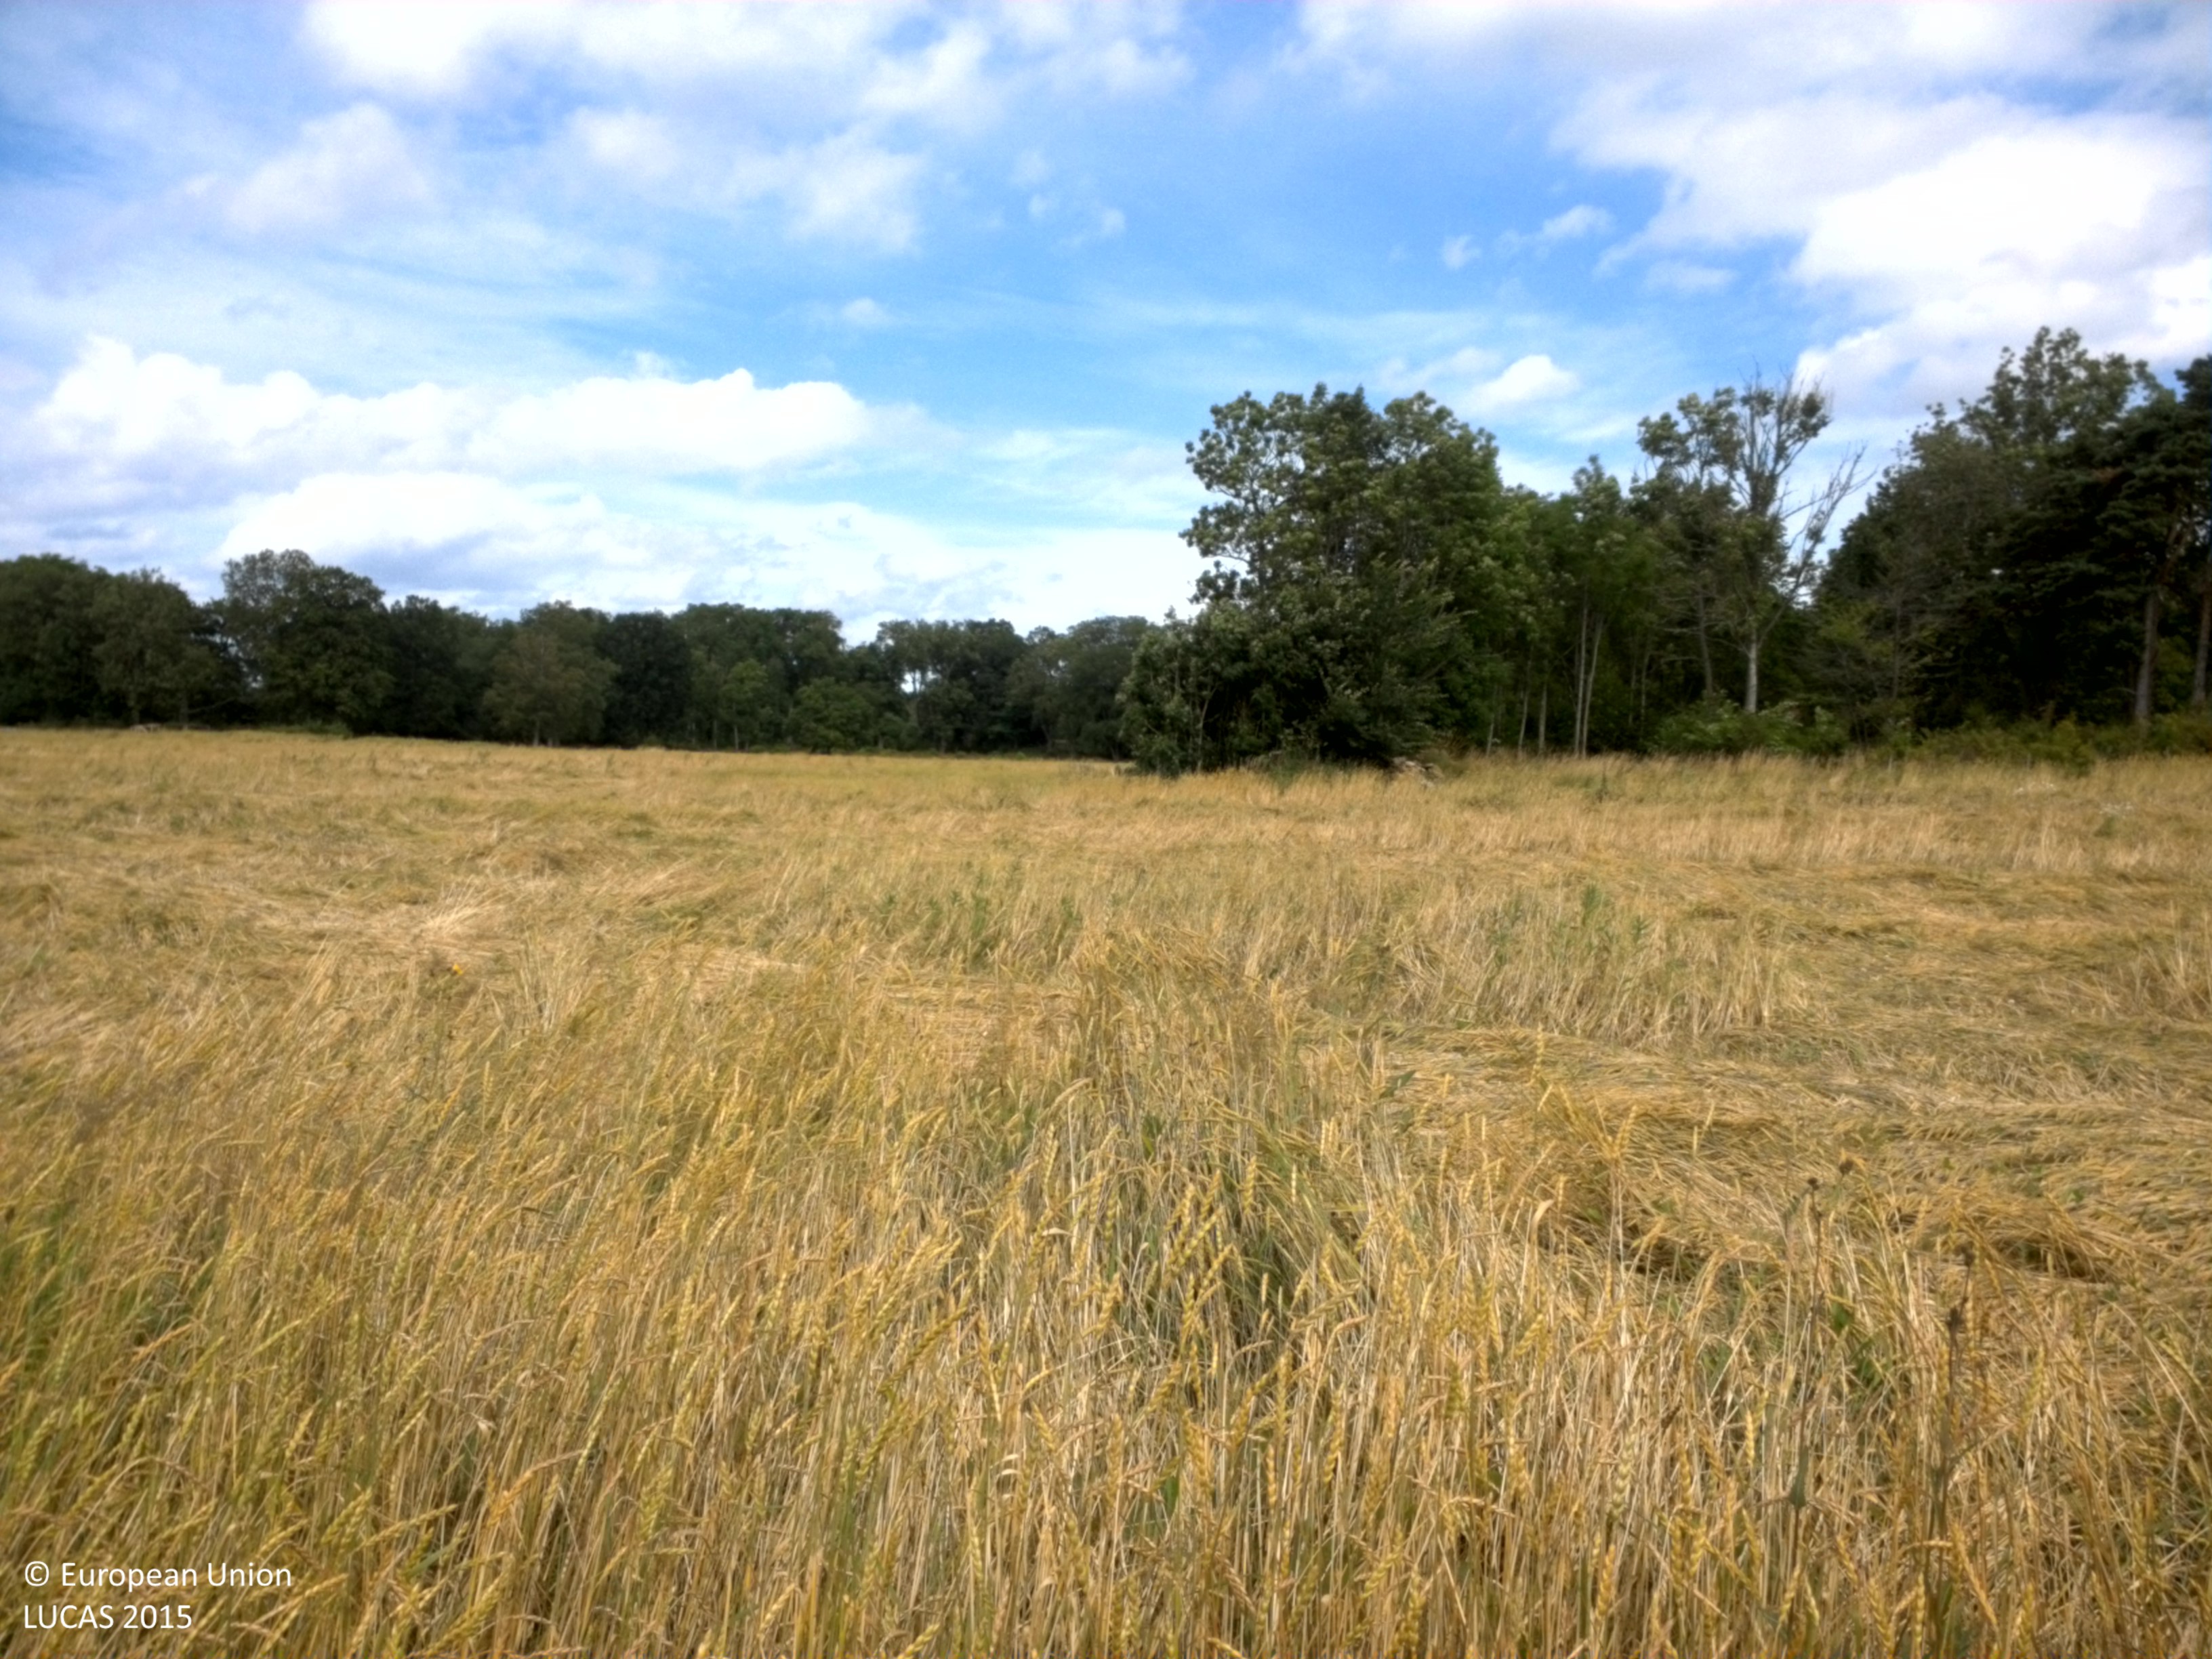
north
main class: Cropland
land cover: Common wheat
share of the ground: > 75 %
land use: Agriculture (excluding fallow land and kitchen gardens)
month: July
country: SE
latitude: 58.5380
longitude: 13.3436
